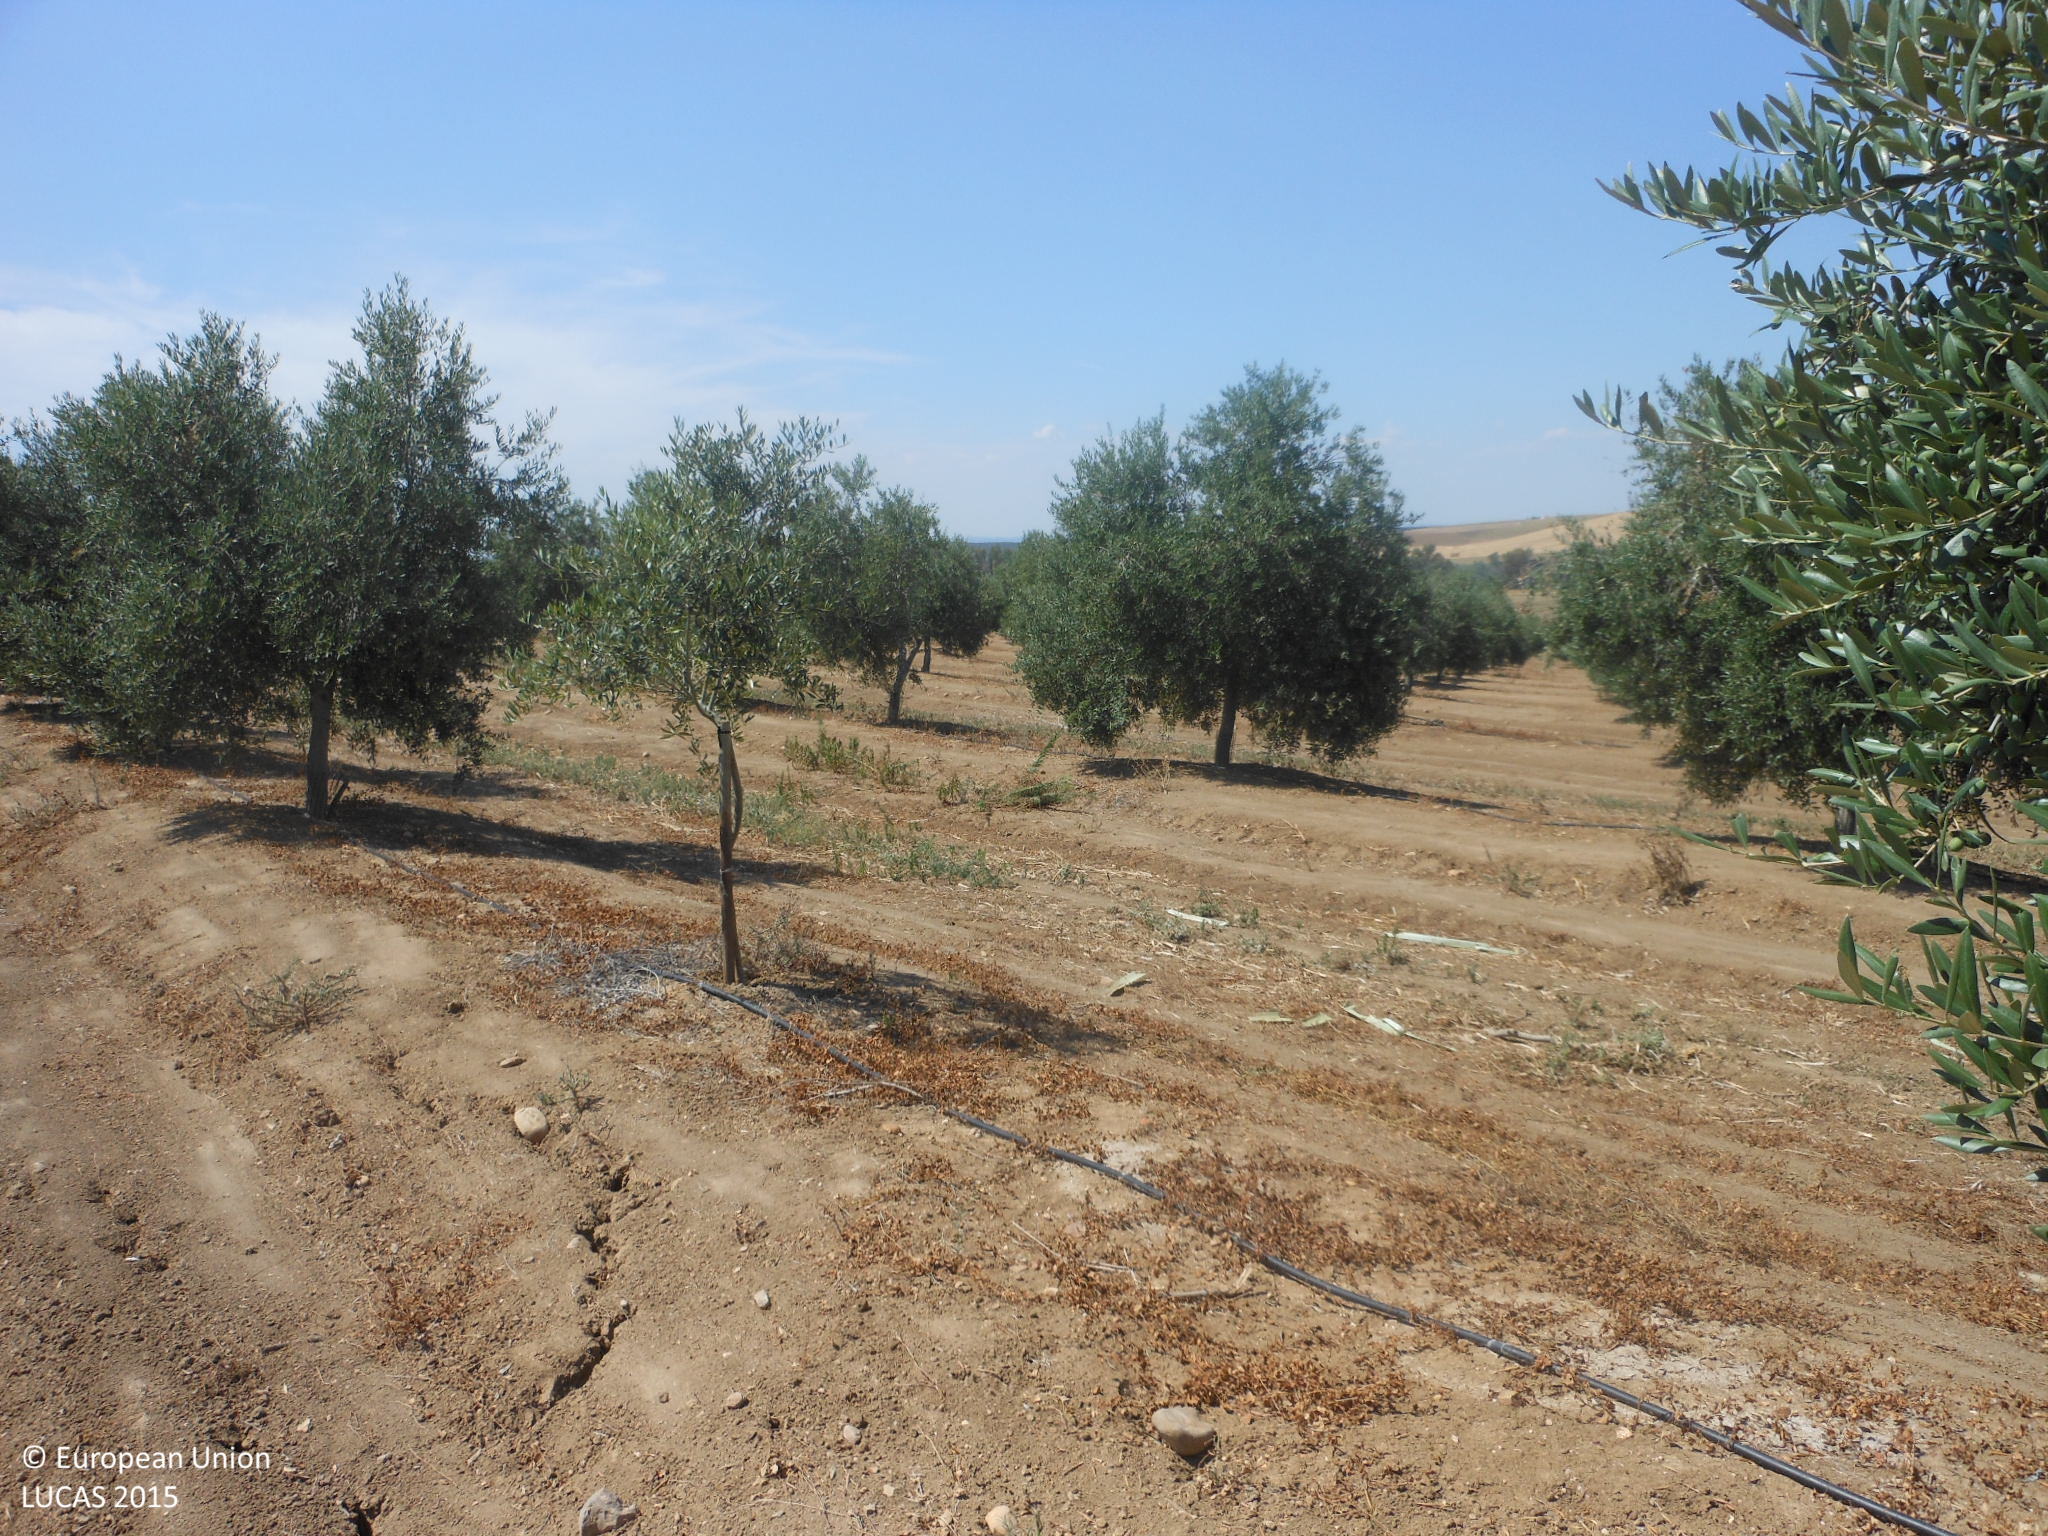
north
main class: Cropland
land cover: Olive groves
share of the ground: 50 - 75 %
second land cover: Other bare soil
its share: > 75 %
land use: Agriculture (excluding fallow land and kitchen gardens)
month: June
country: ES
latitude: 37.6424
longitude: -5.1910
